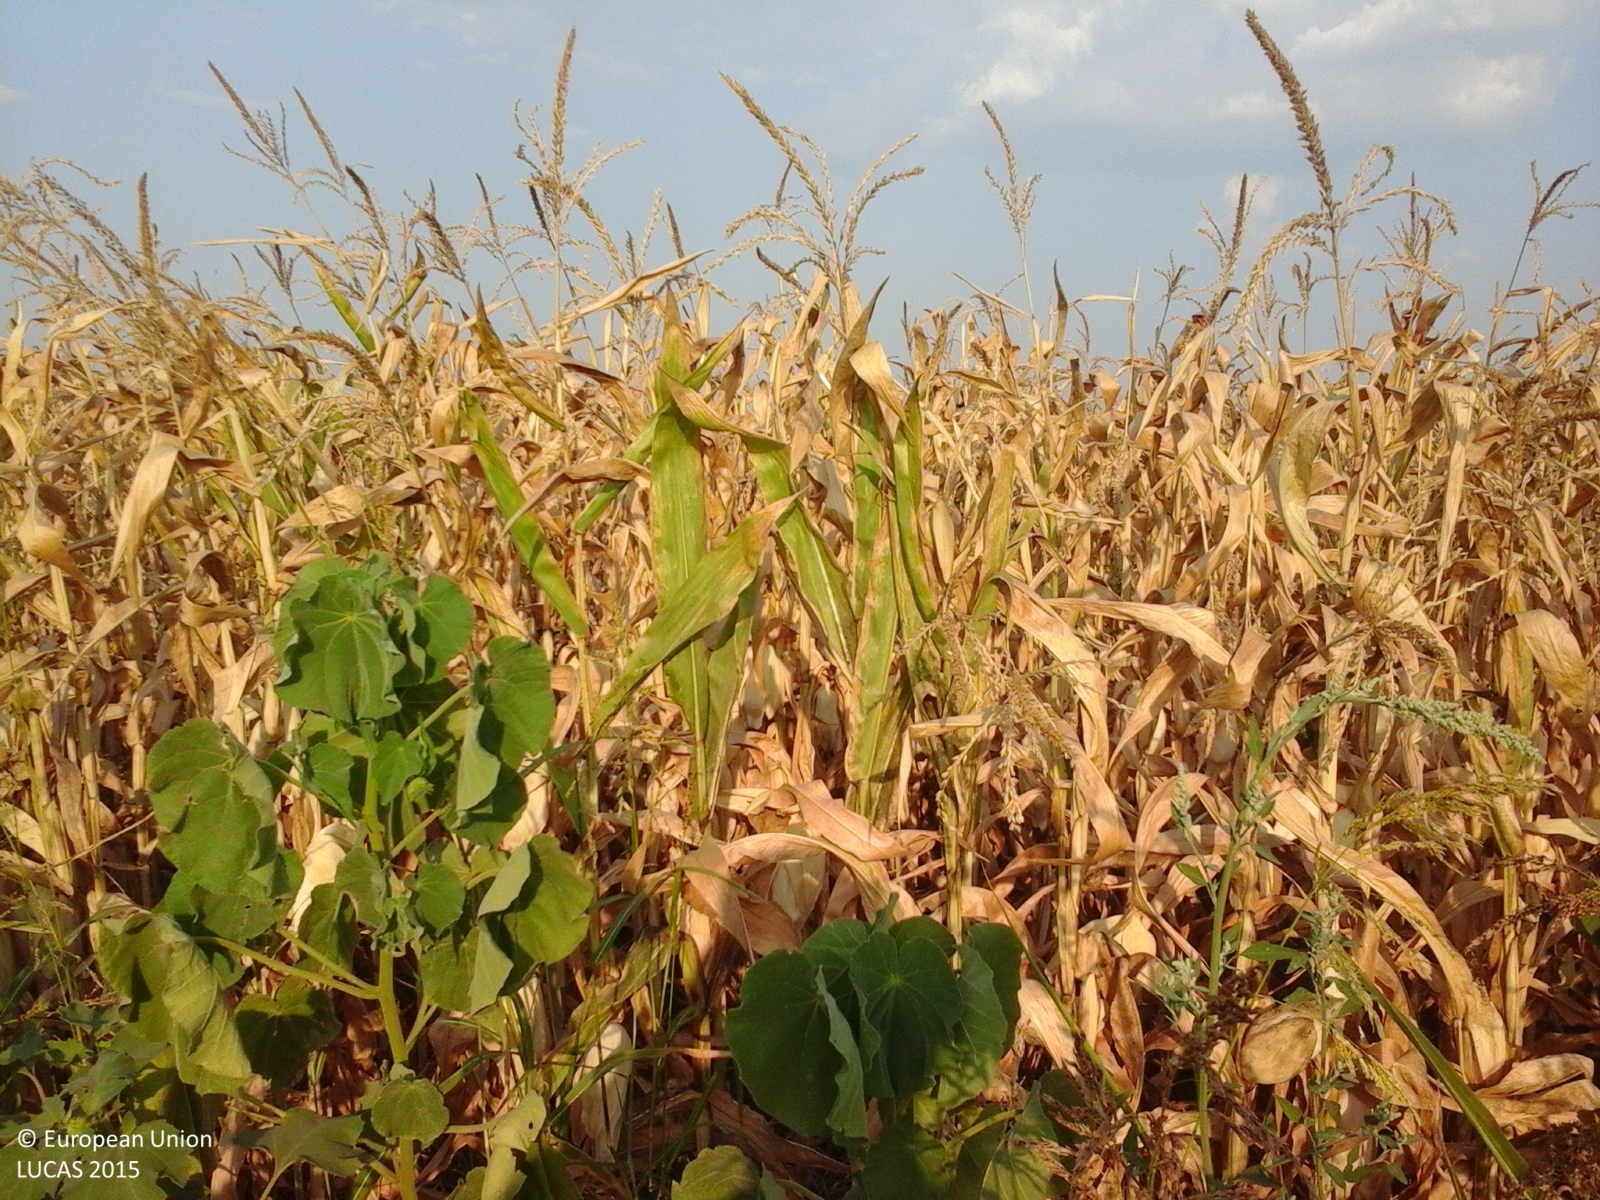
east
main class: Cropland
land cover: Maize
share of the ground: > 75 %
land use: Agriculture (excluding fallow land and kitchen gardens)
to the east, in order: Maize
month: August
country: RO
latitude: 43.9783
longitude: 23.1962
